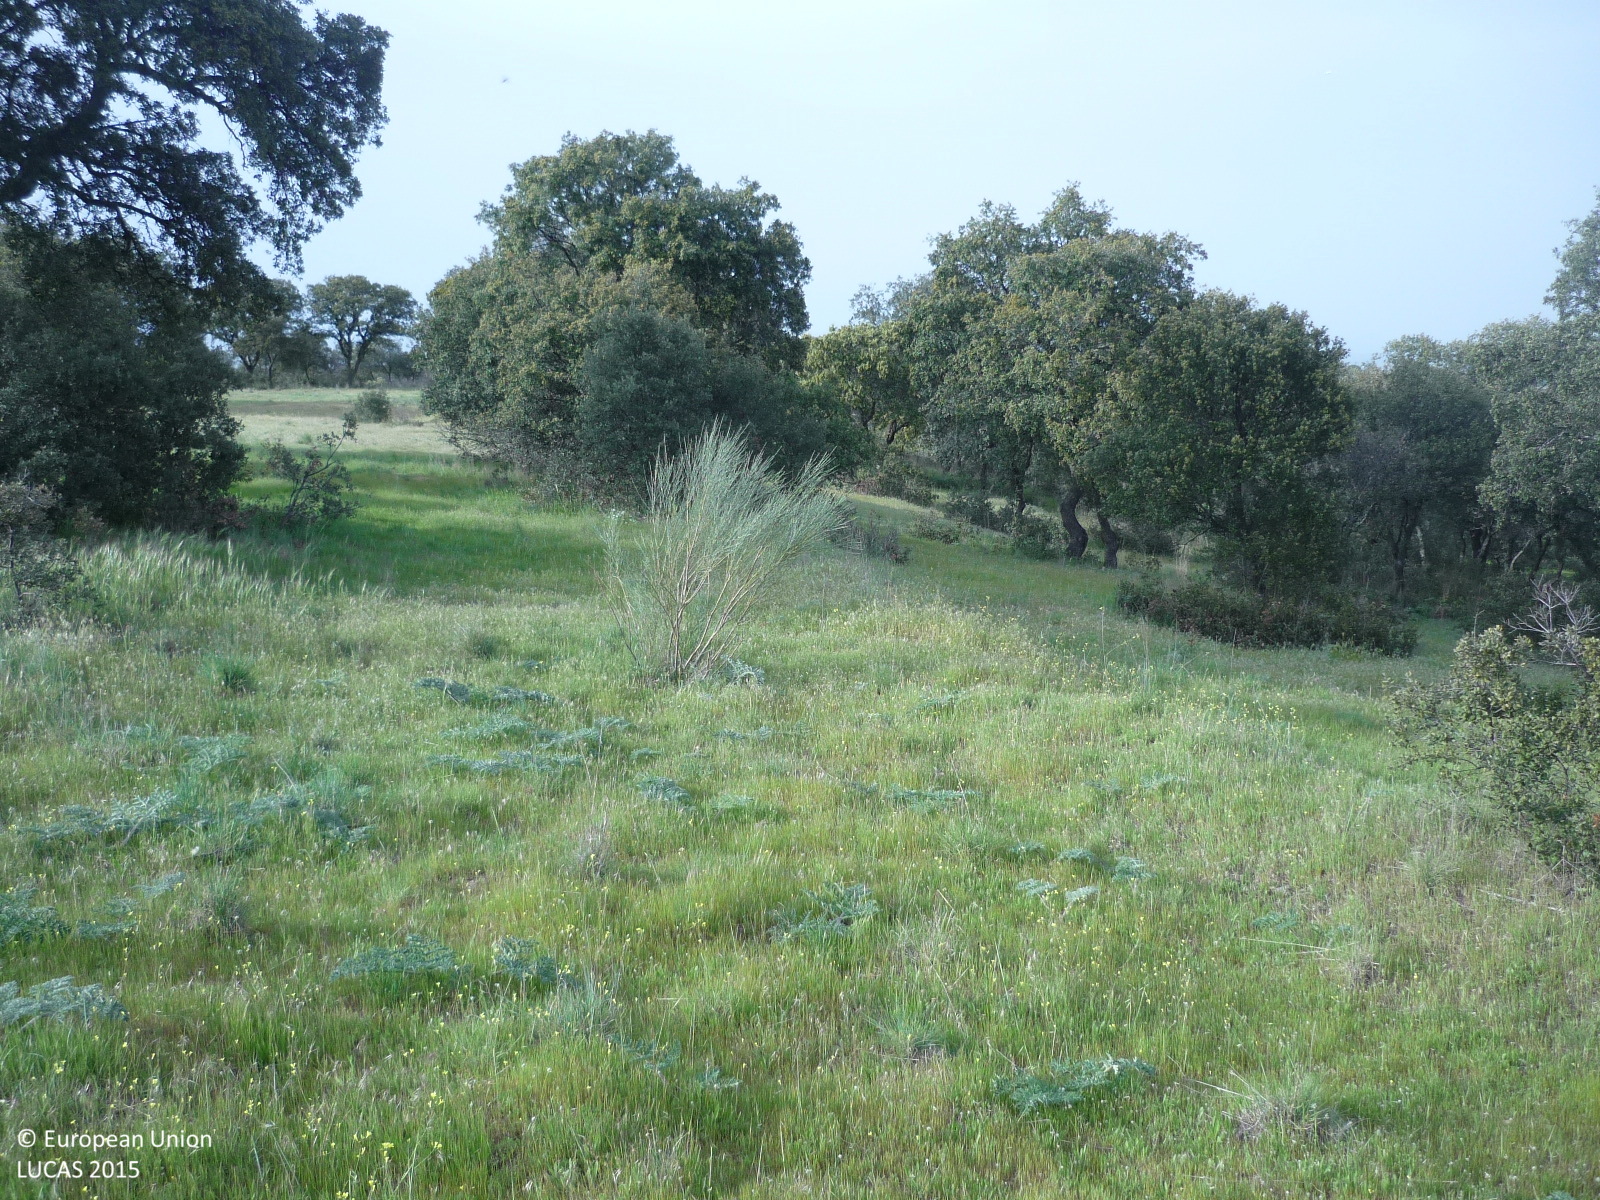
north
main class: Woodland
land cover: Broadleaved woodland
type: broadleaved evergreen forest
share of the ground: 25 - 50 %
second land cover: Grassland without tree/shrub cover
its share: > 75 %
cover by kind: herbaceous plants 70 %, broadleaved forest trees 30 %
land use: Agriculture (excluding fallow land and kitchen gardens)
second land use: Amenities, museums, leisure
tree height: < 5 m
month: April
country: ES
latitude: 40.5985
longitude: -3.5926
